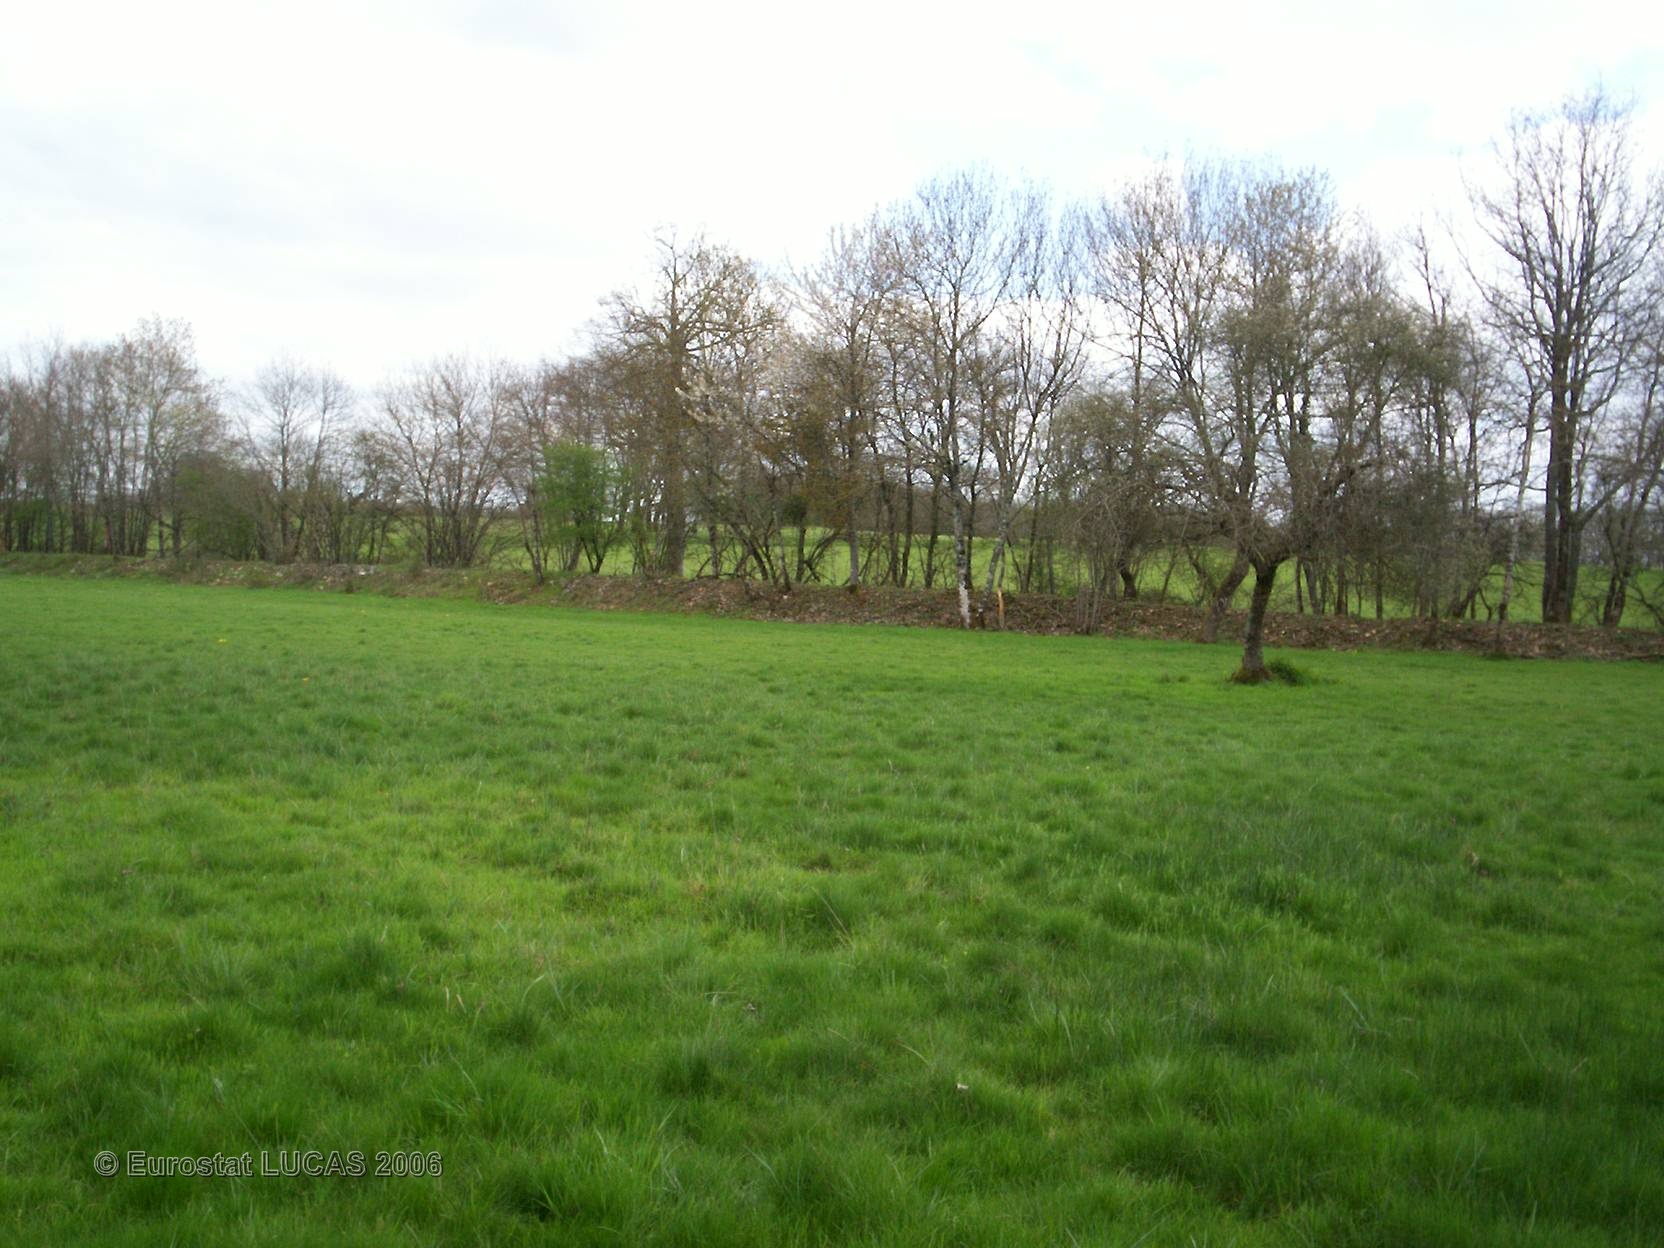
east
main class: Grassland
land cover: Grassland without tree/shrub cover
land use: Agriculture (excluding fallow land and kitchen gardens)
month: April
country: FR
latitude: 46.2384
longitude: 0.5301
